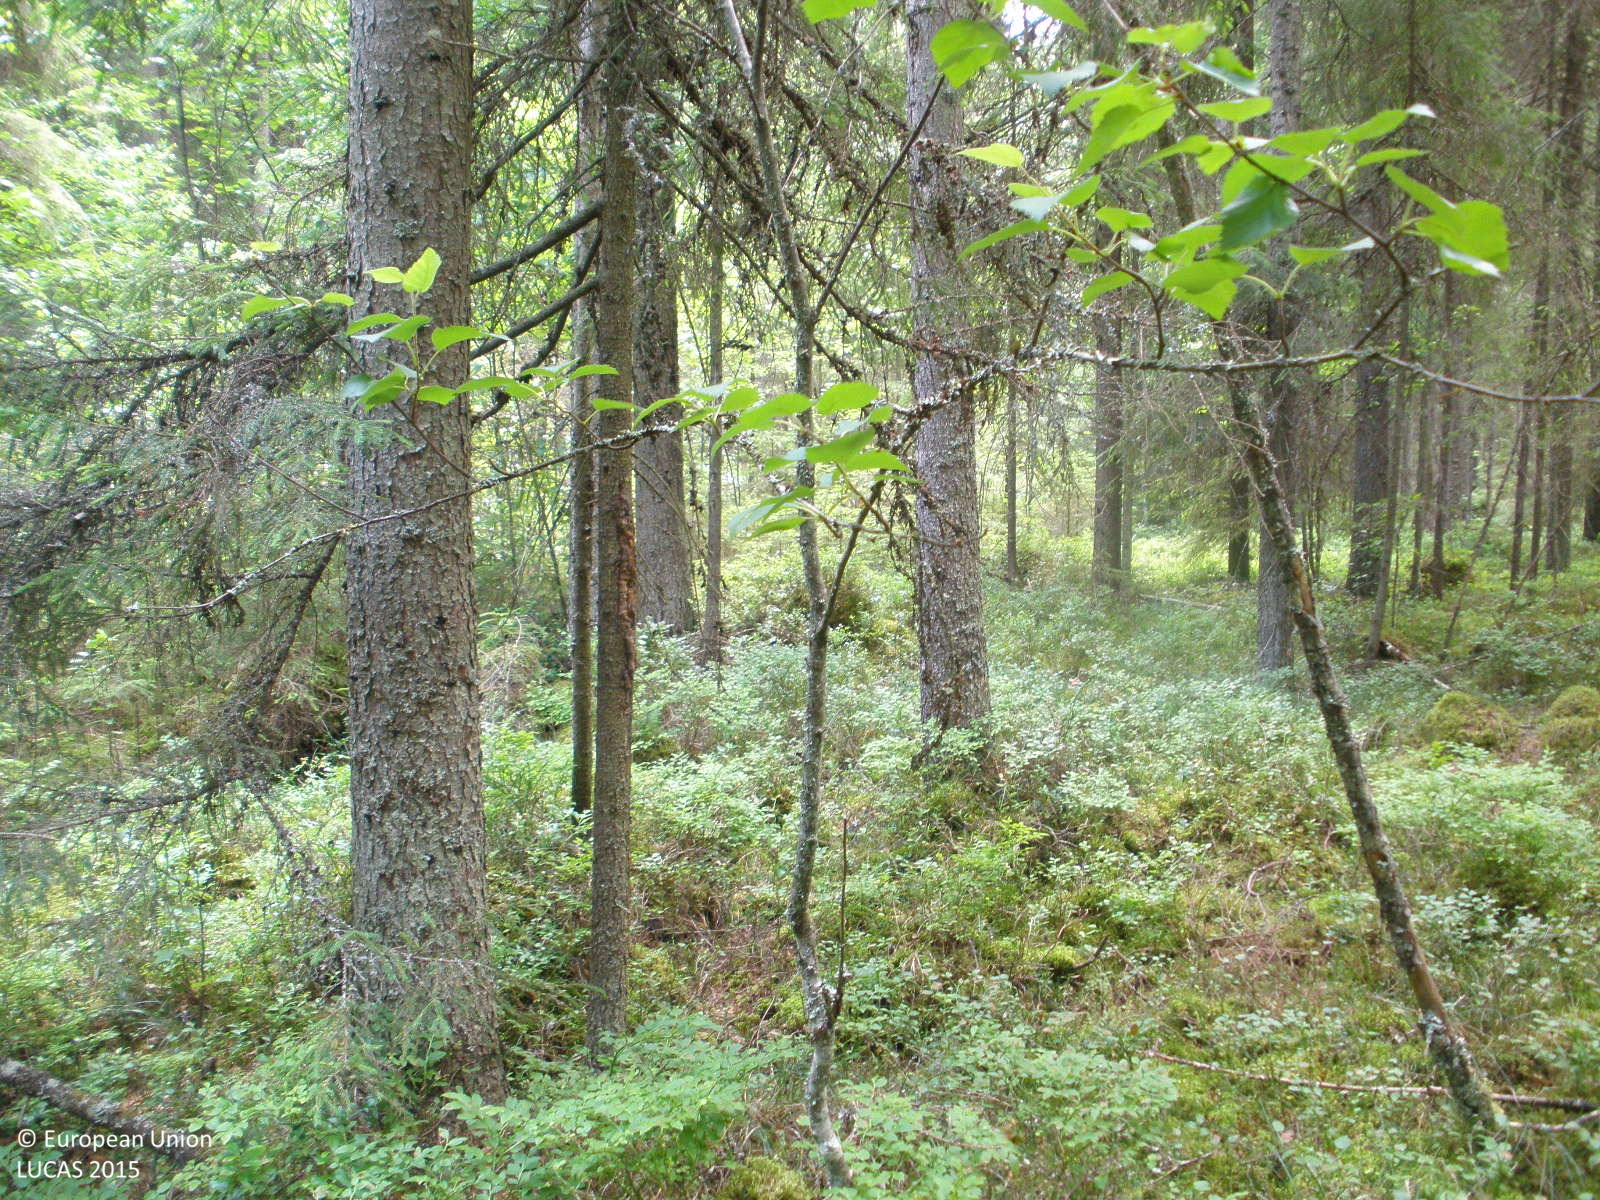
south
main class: Woodland
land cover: Spruce dominated coniferous woodland
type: boreal forest
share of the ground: > 75 %
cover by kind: coniferous forest trees 85 %, broadleaved forest trees 5 %, herbaceous plants 5 %, lichens and mosses 5 %
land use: Forestry
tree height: > 5 m
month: July
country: FI
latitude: 61.4901
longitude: 24.9643
